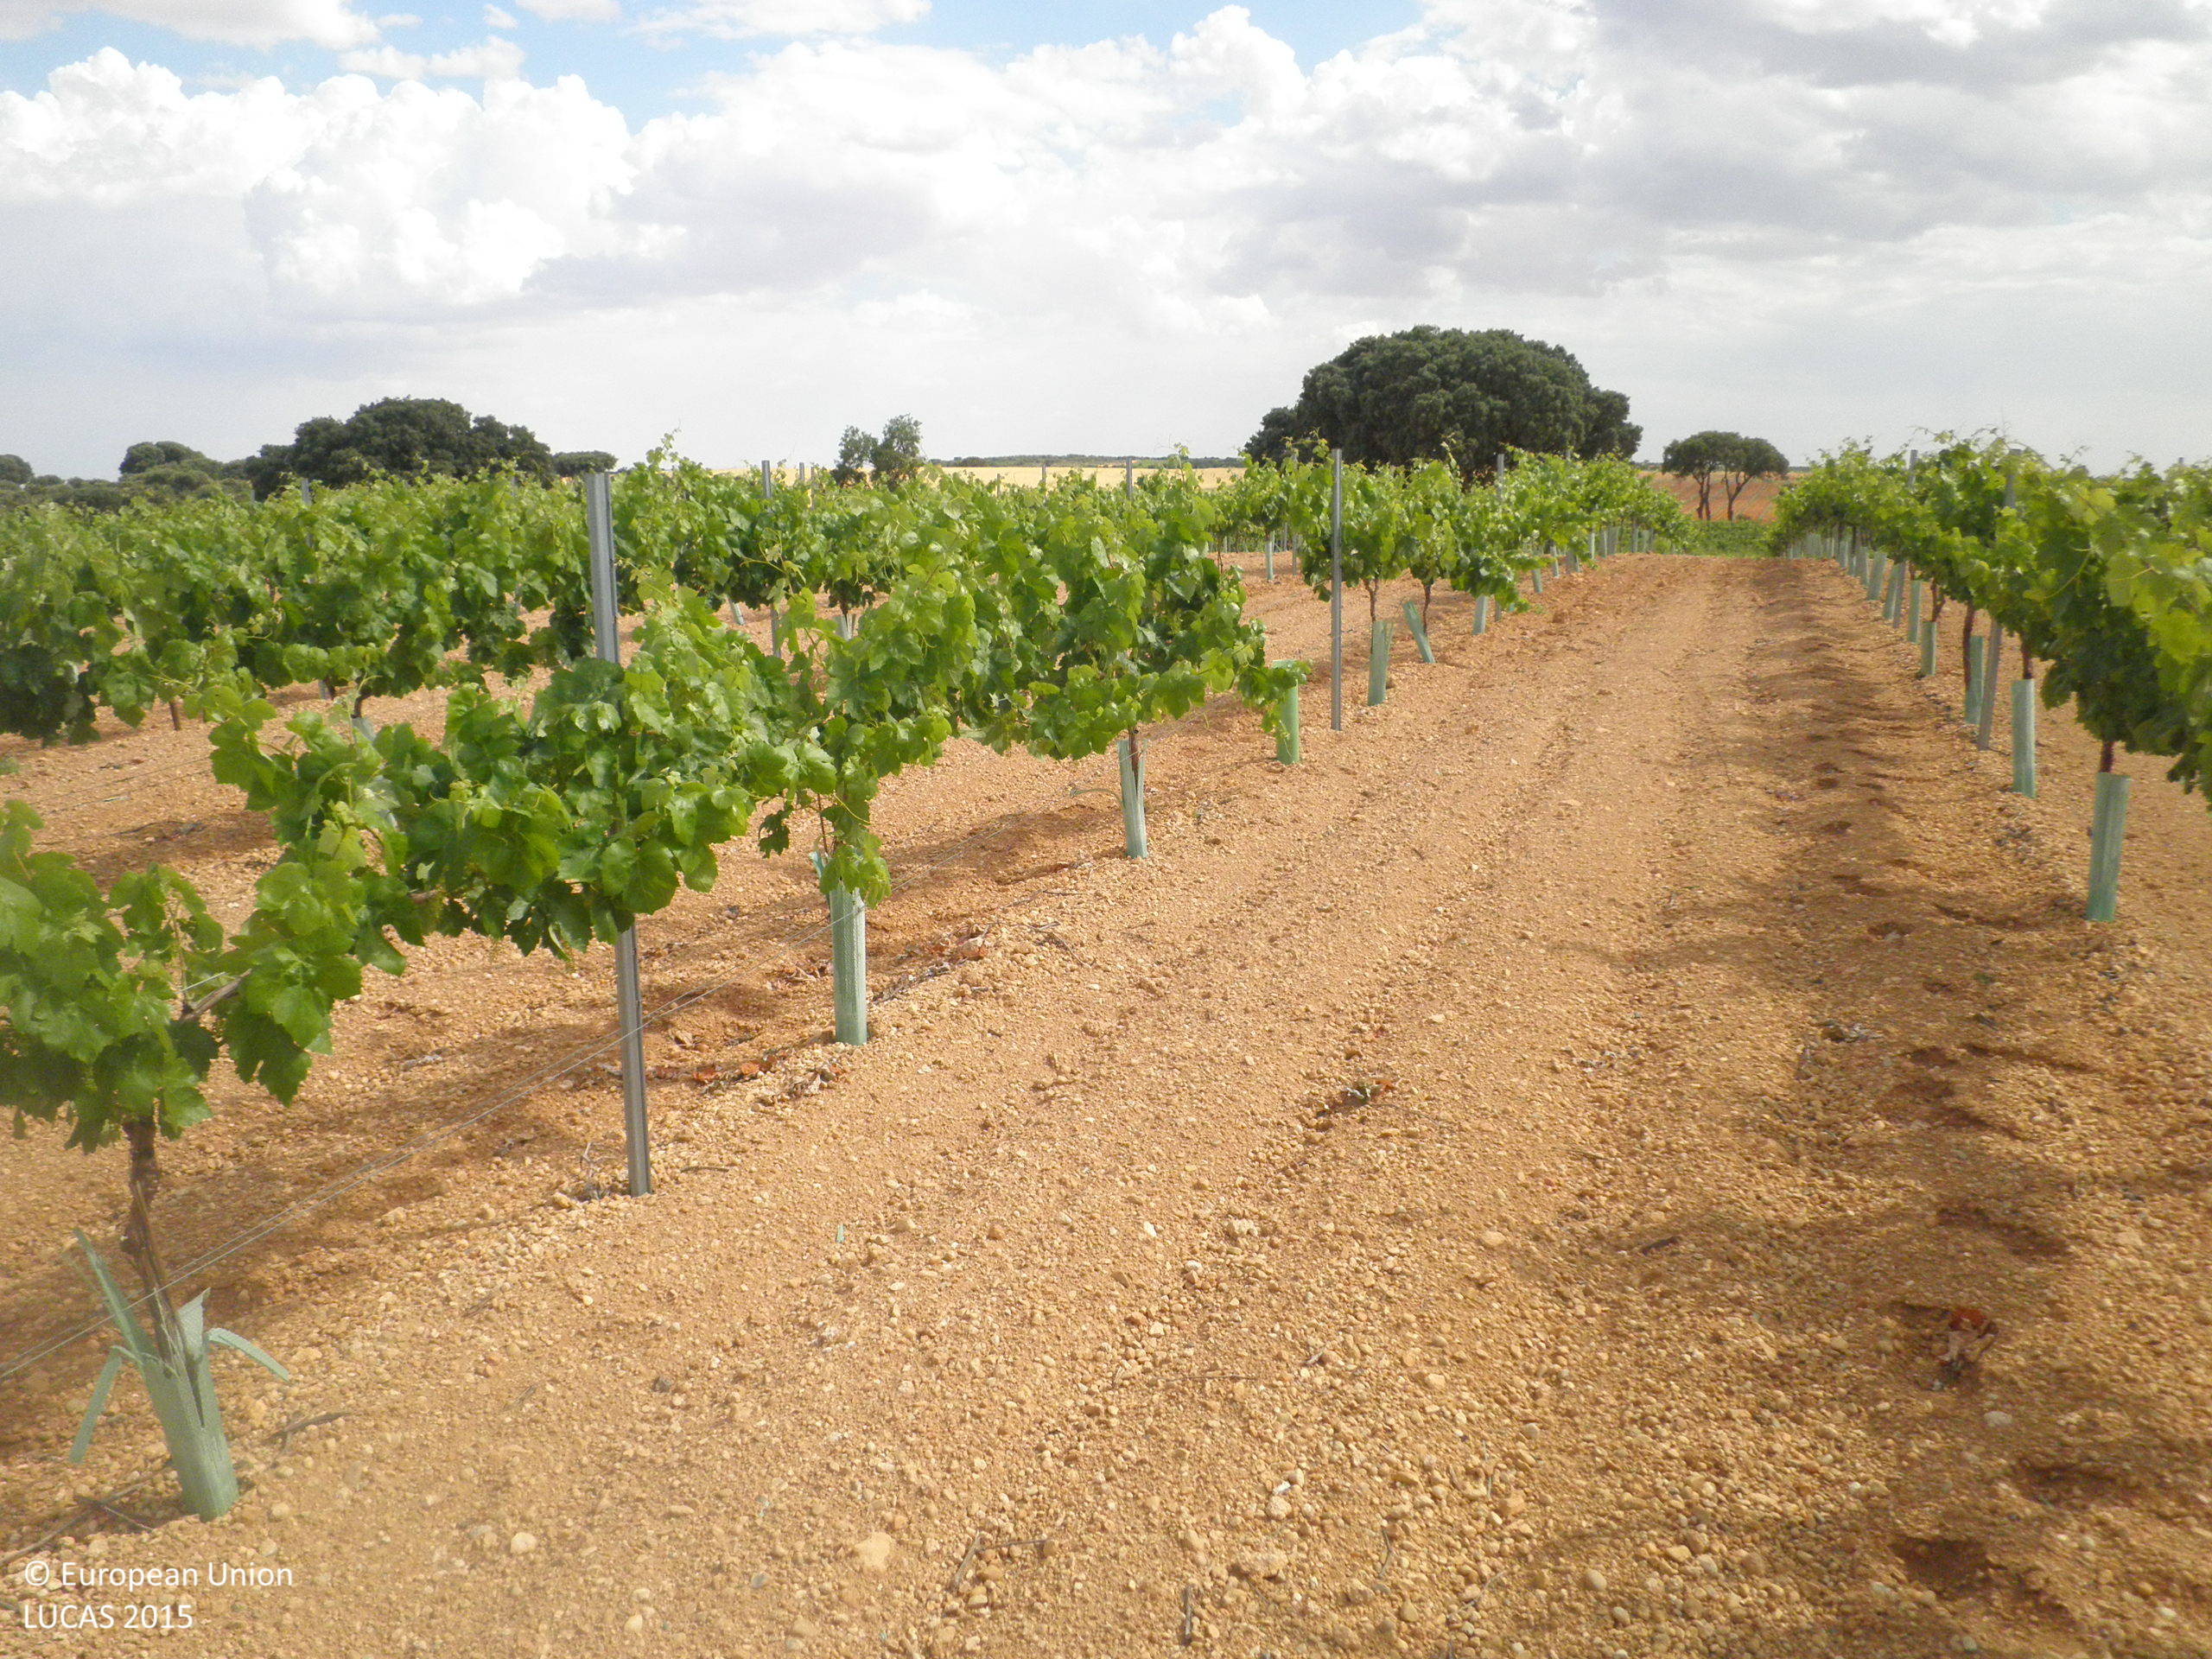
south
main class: Cropland
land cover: Vineyards
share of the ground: < 10 %
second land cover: Other bare soil
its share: > 75 %
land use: Agriculture (excluding fallow land and kitchen gardens)
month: June
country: ES
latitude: 39.4760
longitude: -1.8287
